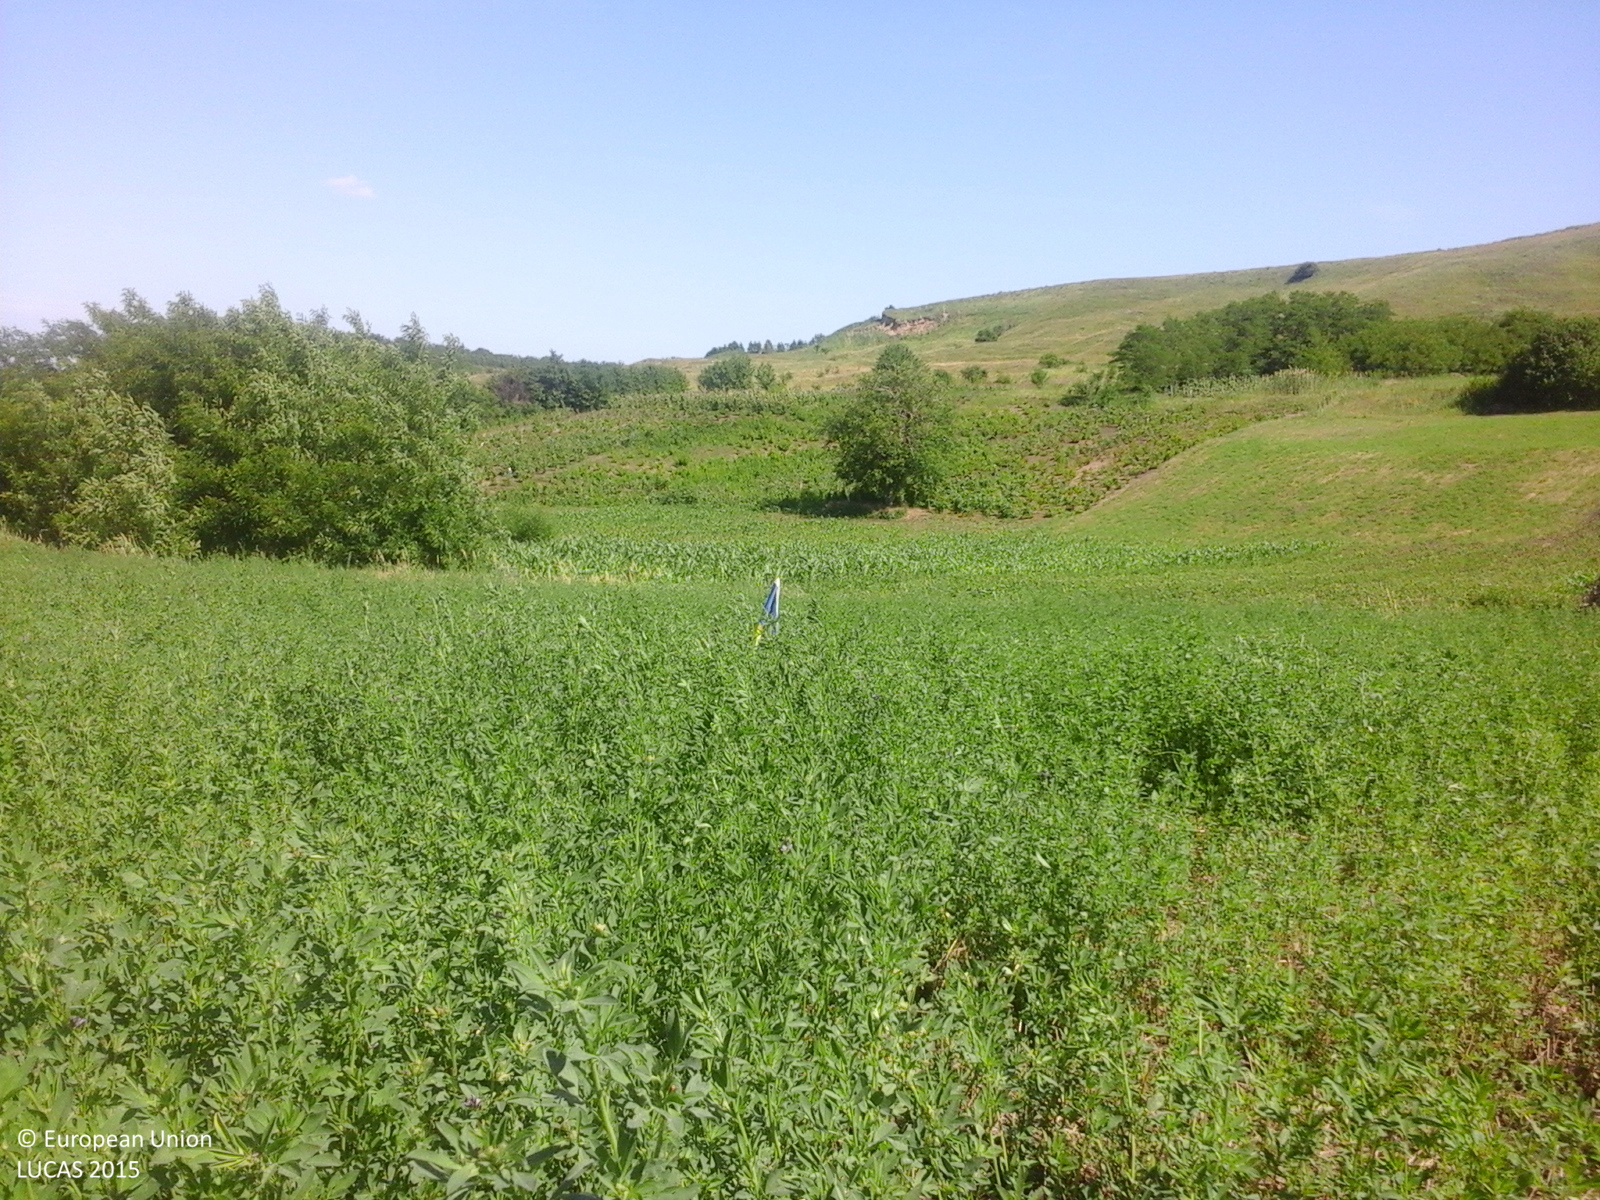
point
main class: Cropland
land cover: Lucerne
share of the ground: > 75 %
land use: Agriculture (excluding fallow land and kitchen gardens)
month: June
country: RO
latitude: 47.5591
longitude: 27.1869
